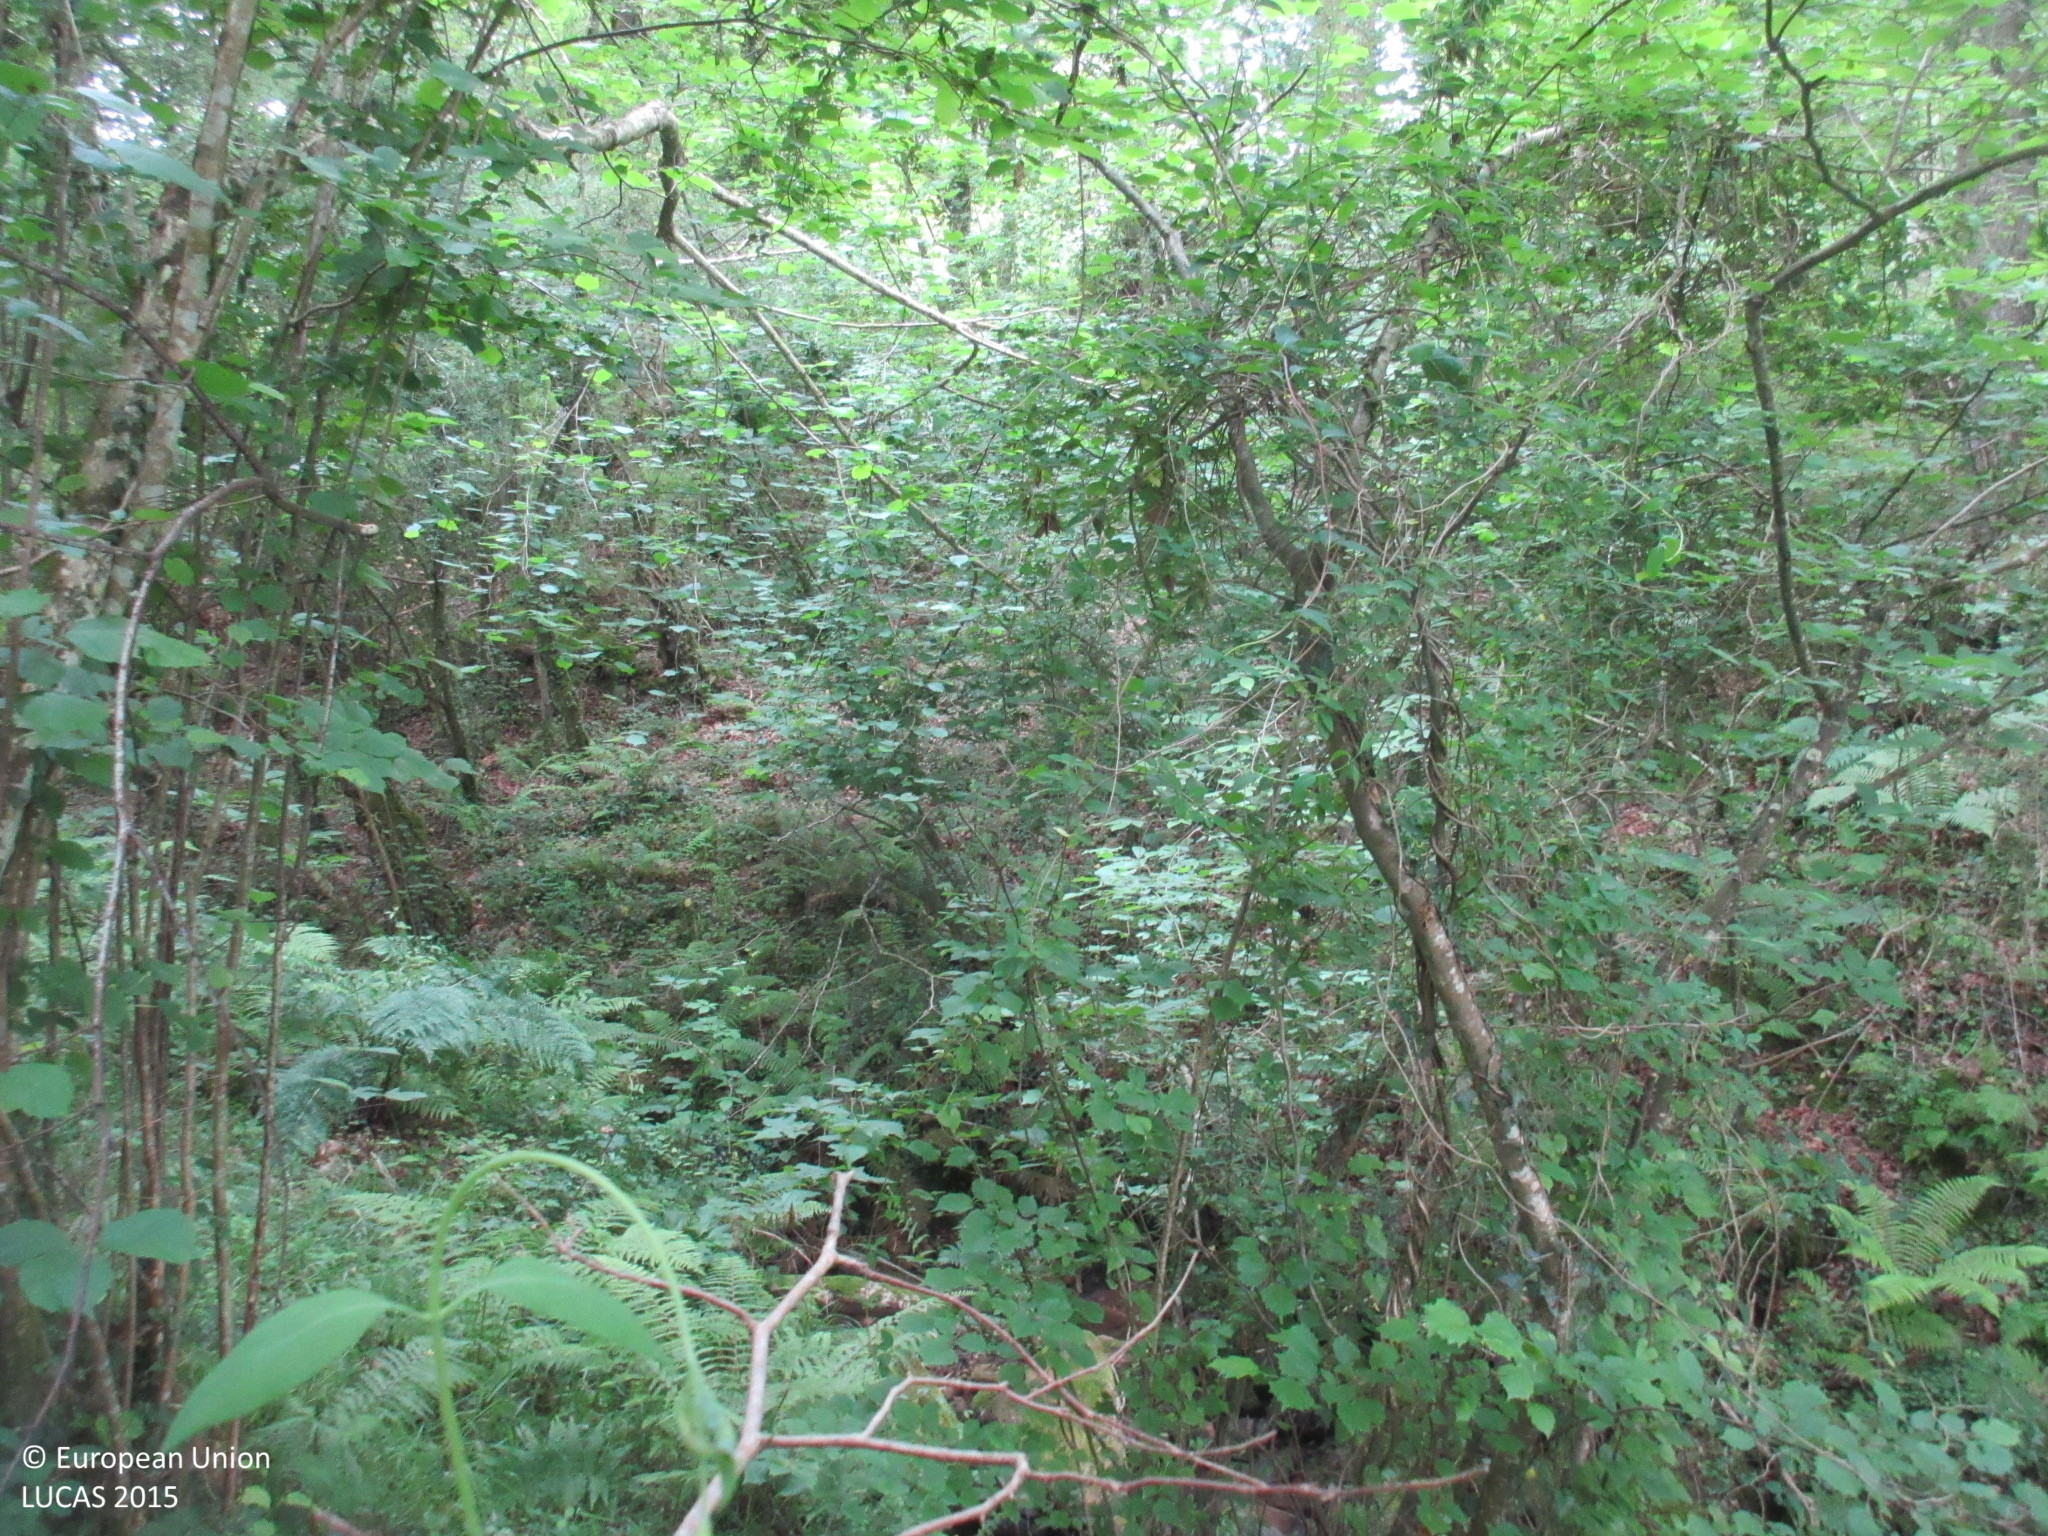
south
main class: Woodland
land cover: Broadleaved woodland
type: floodplain forest
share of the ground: > 75 %
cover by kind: broadleaved forest trees 100 %
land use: Semi-natural and natural areas not in use
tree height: > 5 m
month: June
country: ES
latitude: 43.2962
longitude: -4.1921
